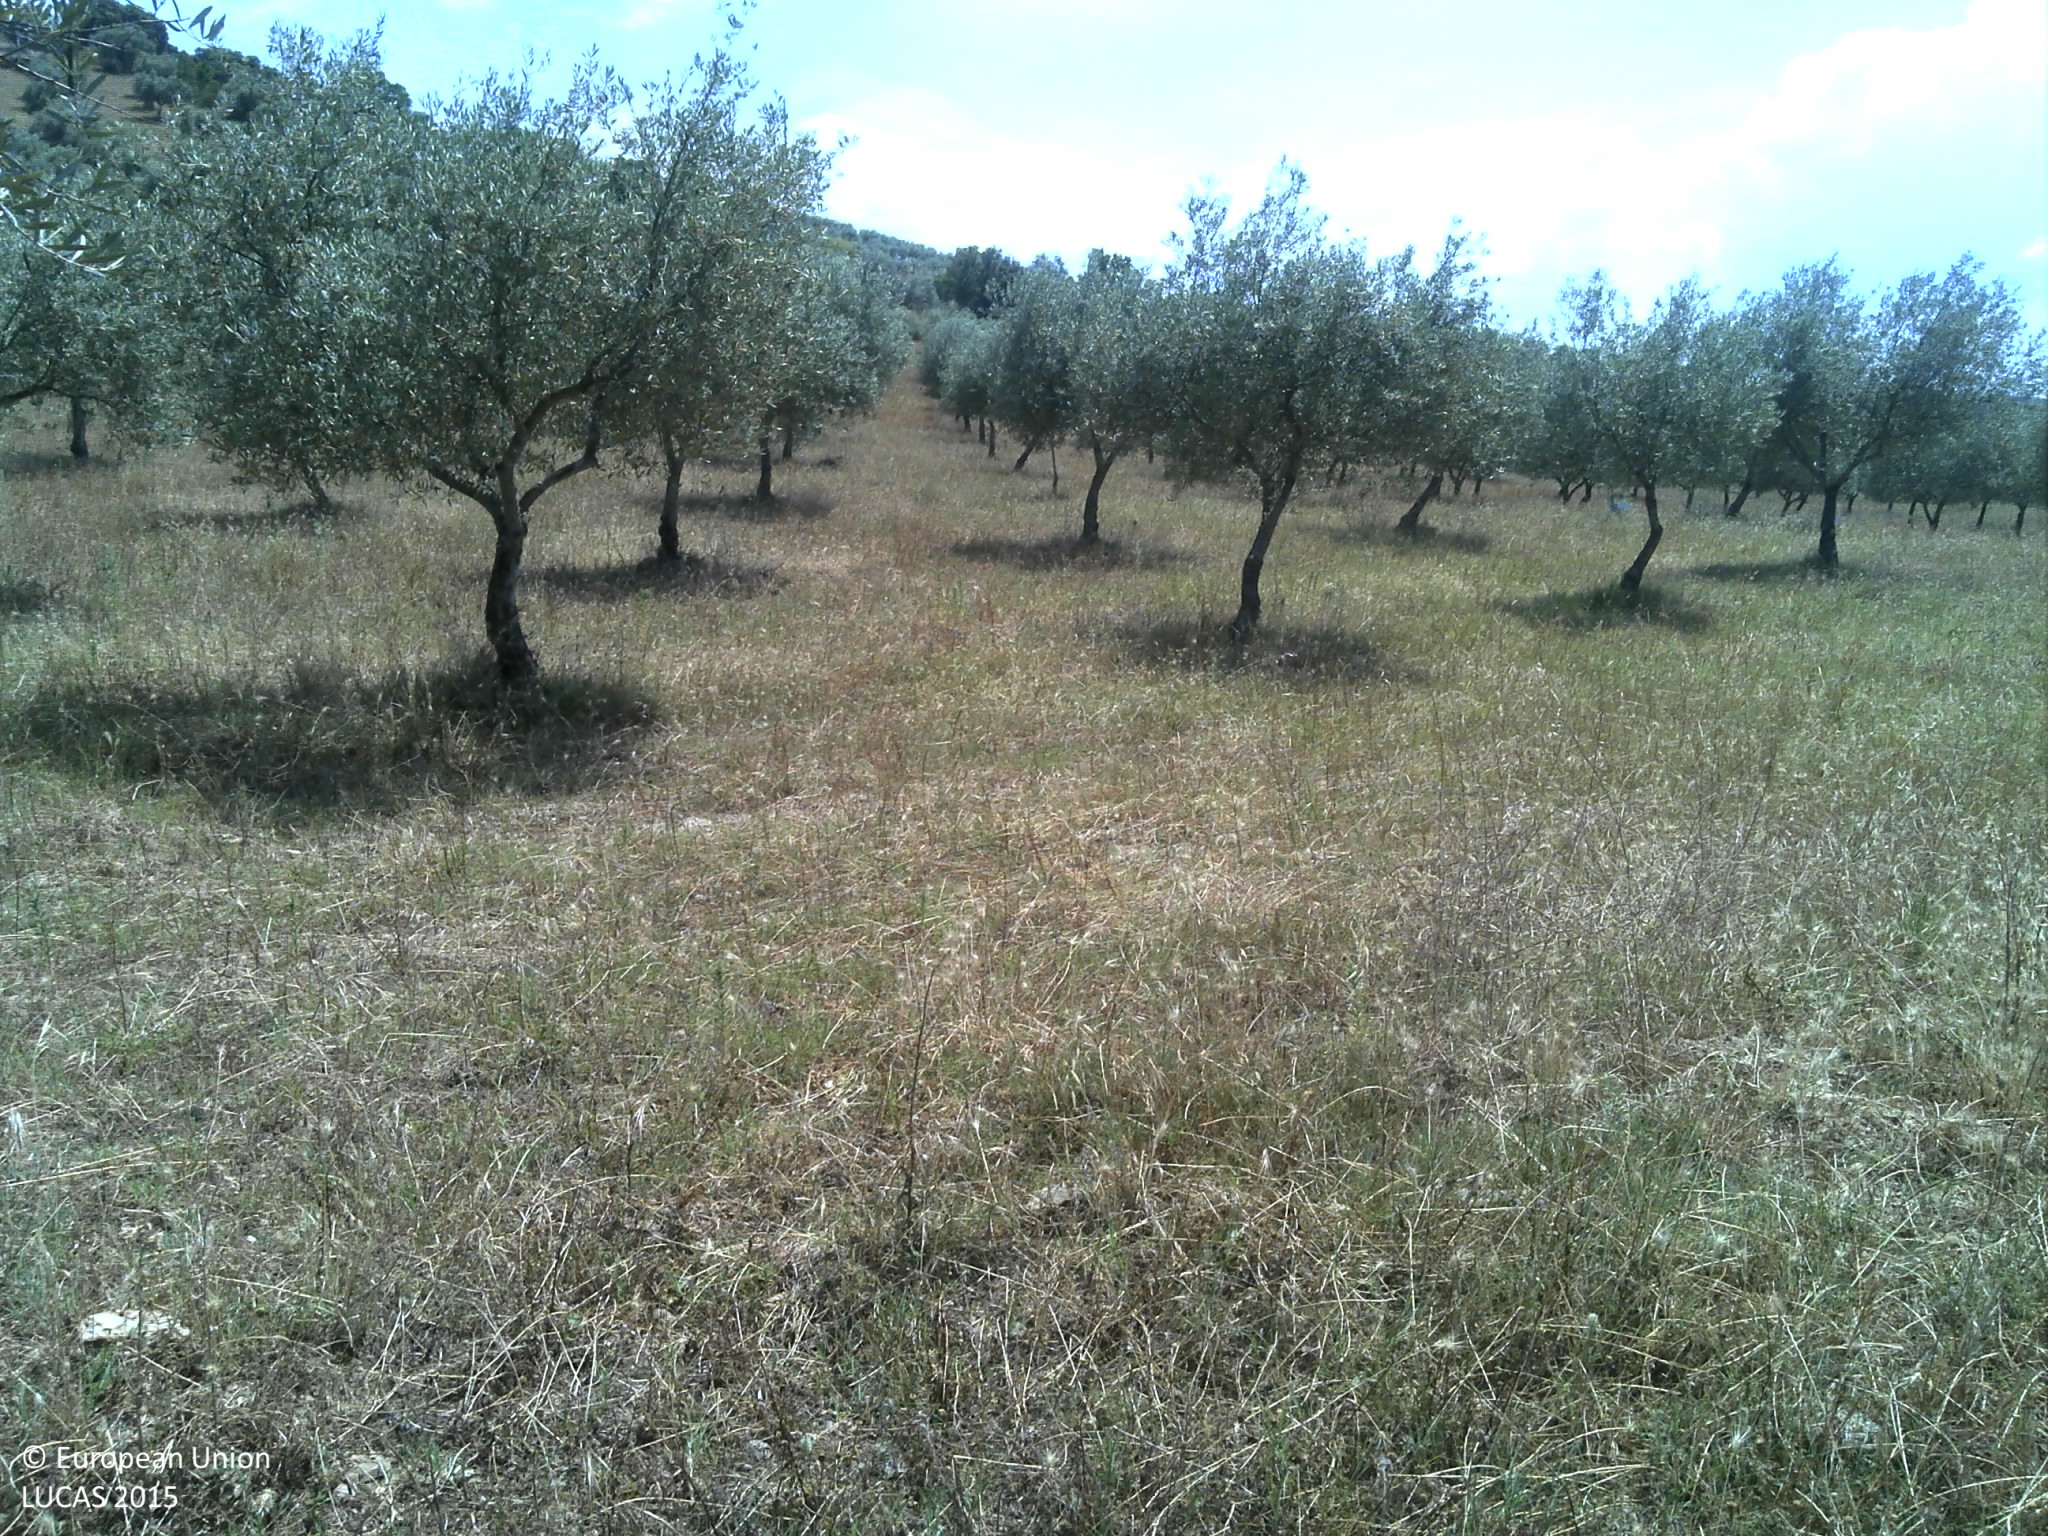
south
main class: Cropland
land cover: Olive groves
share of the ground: < 10 %
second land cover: Spontaneously vegetated surfaces
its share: 25 - 50 %
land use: Agriculture (excluding fallow land and kitchen gardens)
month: June
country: PT
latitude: 41.5151
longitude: -7.1206
